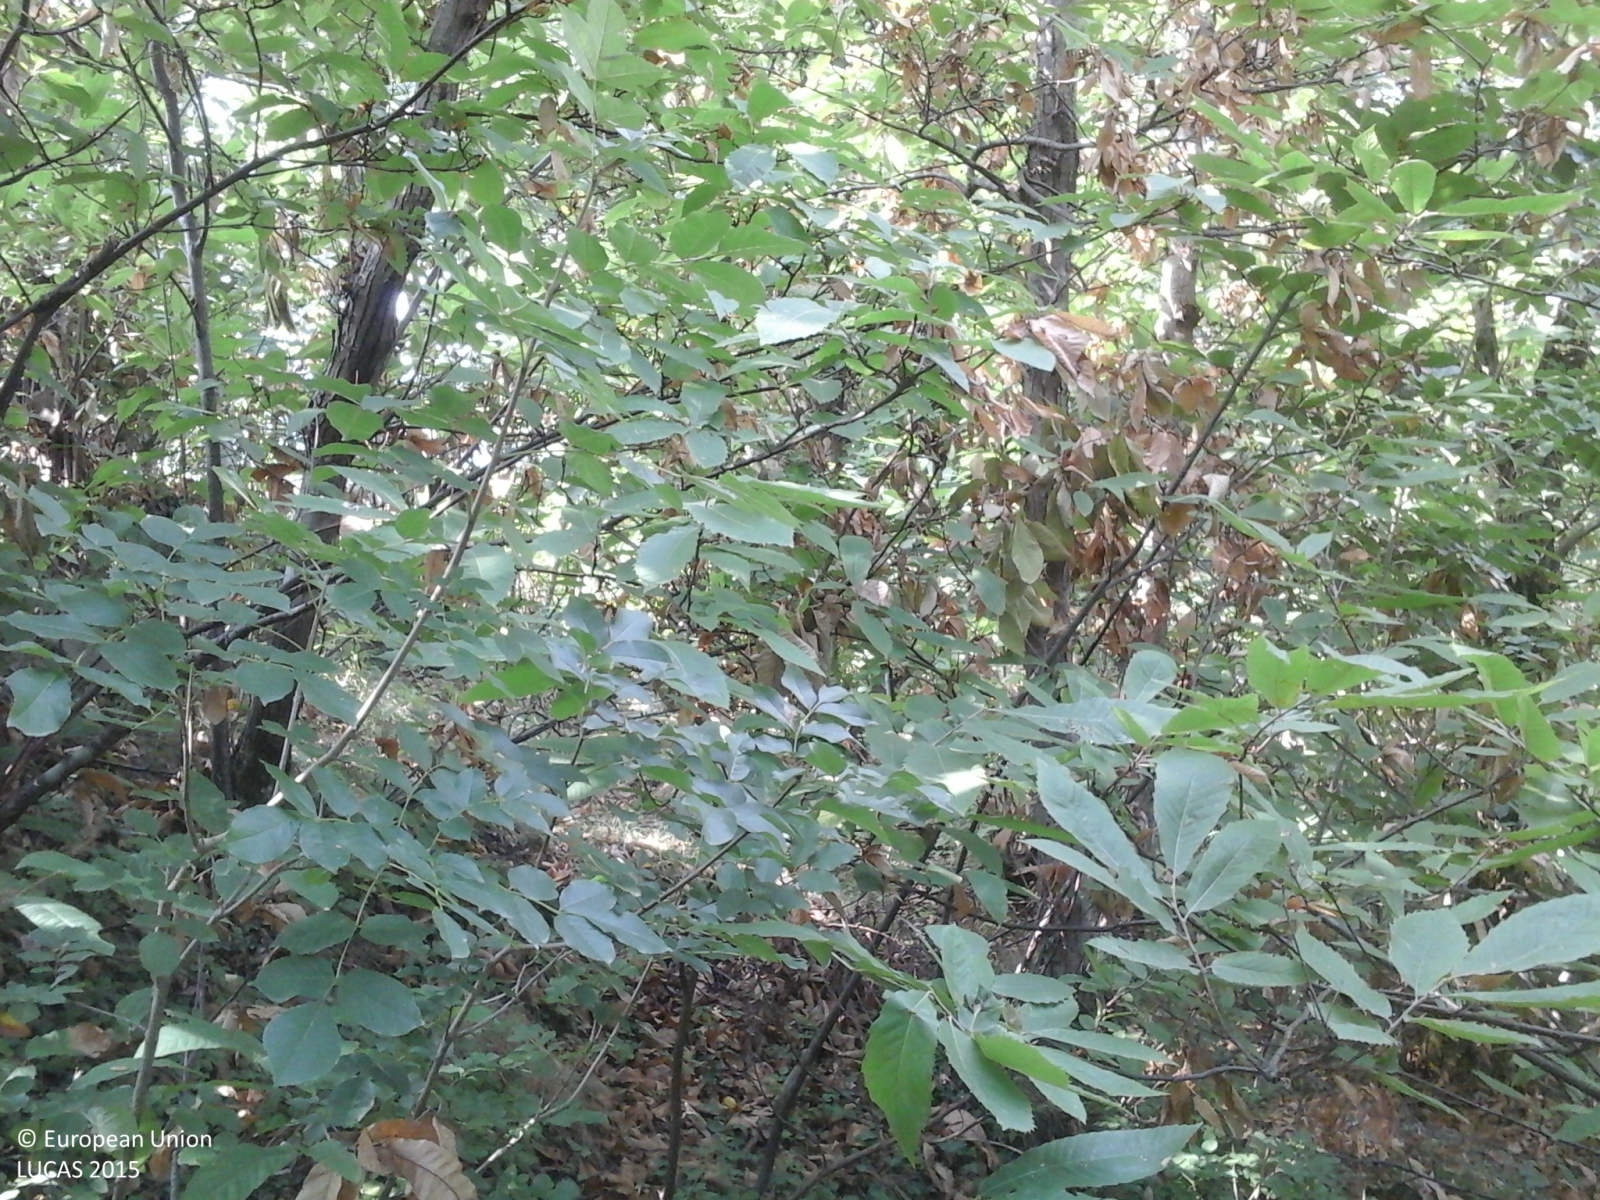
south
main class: Woodland
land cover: Broadleaved woodland
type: mesophytic deciduous forest
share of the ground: > 75 %
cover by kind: broadleaved forest trees 100 %
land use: Forestry
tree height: > 5 m
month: September
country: IT
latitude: 44.4552
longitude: 9.1348
